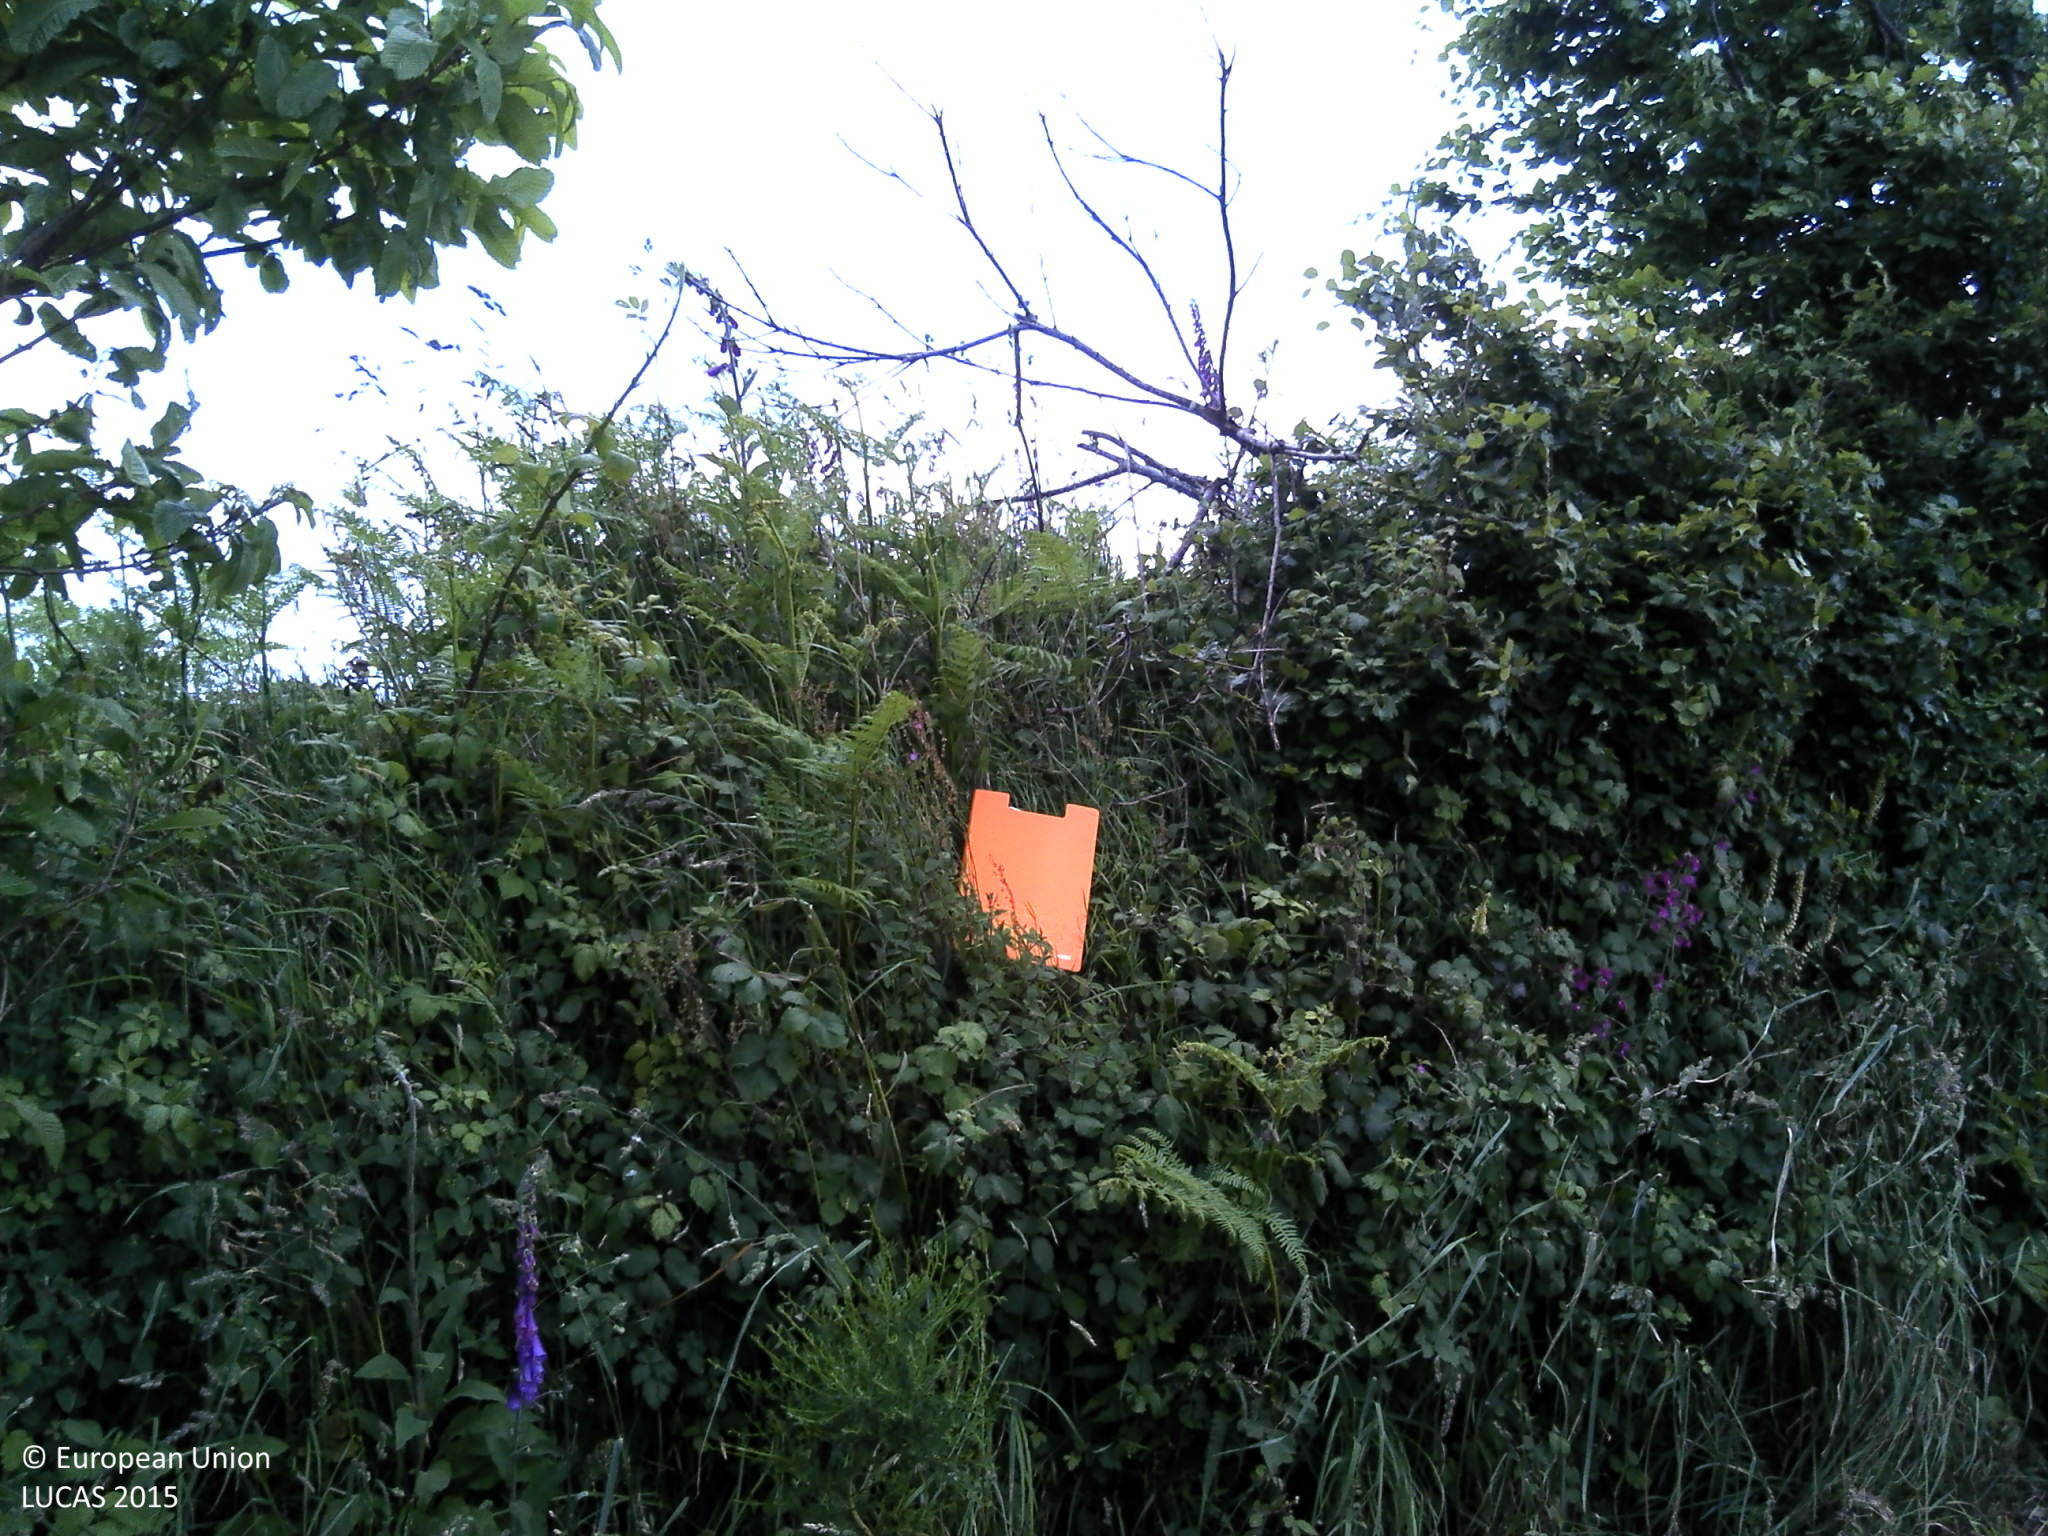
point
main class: Cropland
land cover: Maize
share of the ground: 10 - 25 %
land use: Agriculture (excluding fallow land and kitchen gardens)
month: June
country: FR
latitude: 47.9818
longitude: -3.5695
